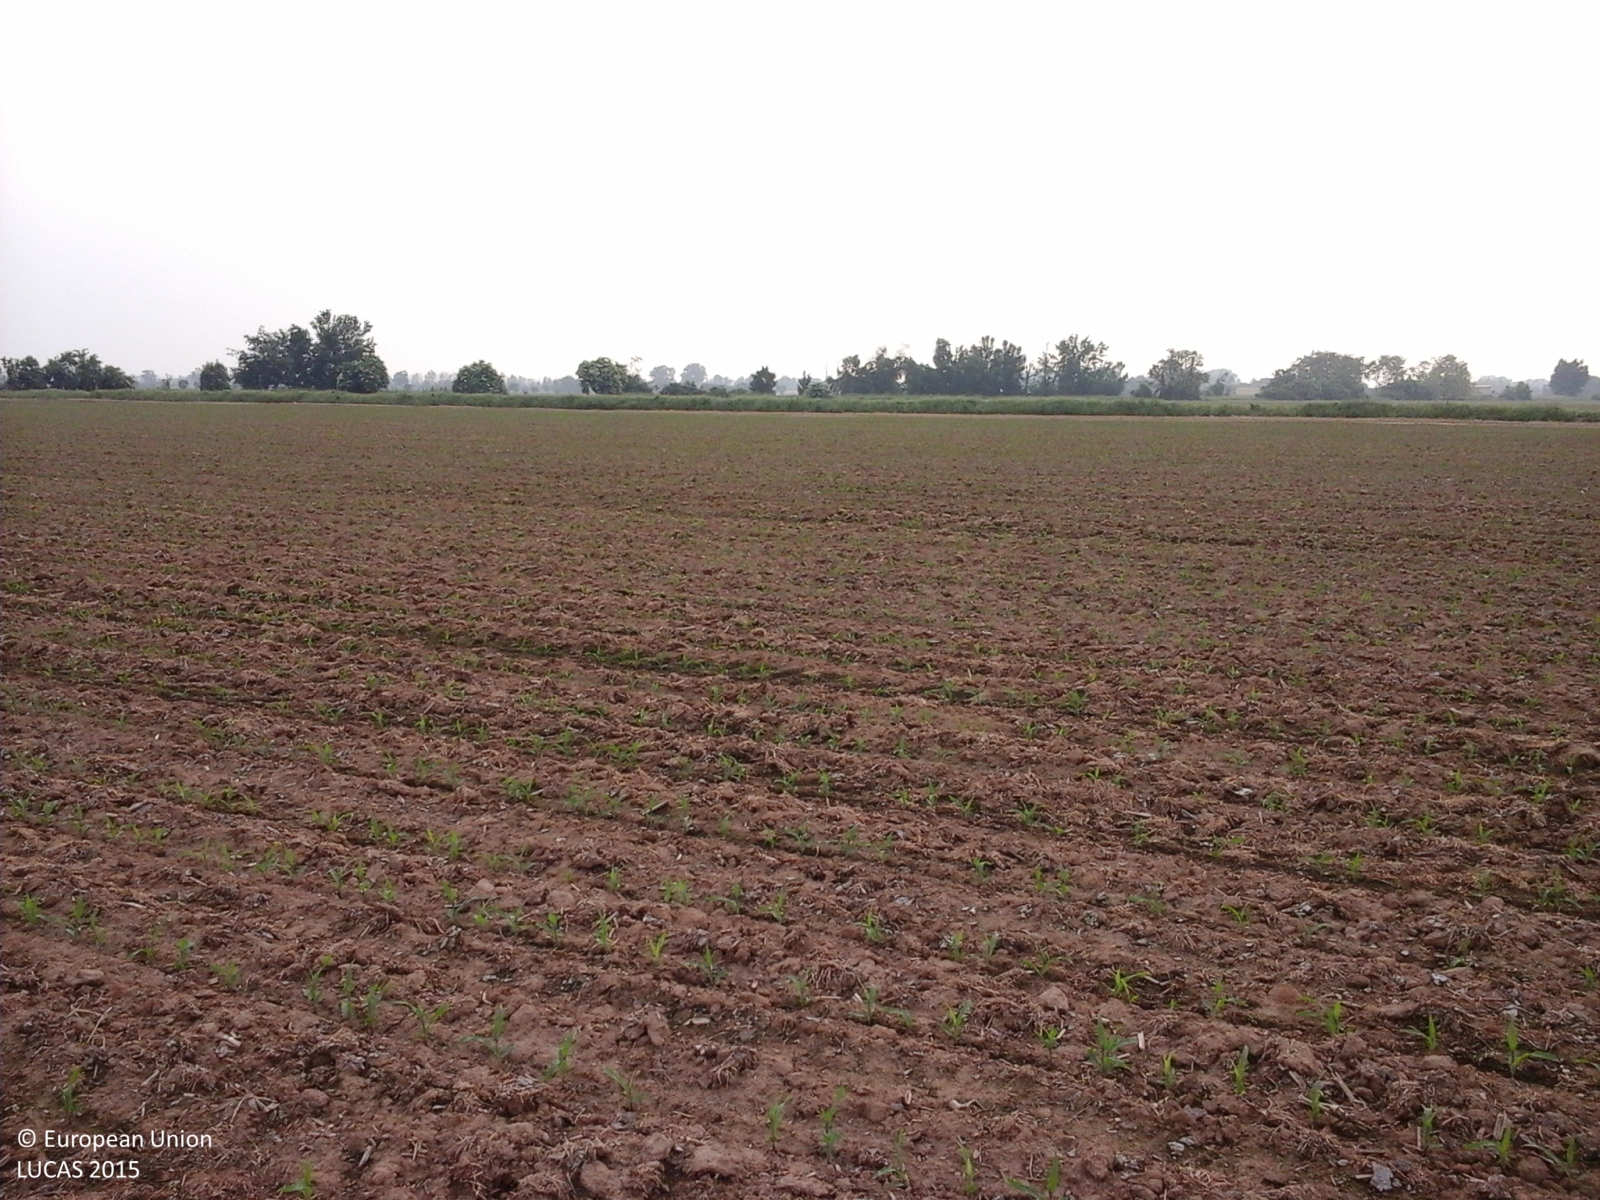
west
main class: Cropland
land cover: Maize
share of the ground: < 10 %
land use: Agriculture (excluding fallow land and kitchen gardens)
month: May
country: IT
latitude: 45.2340
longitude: 9.8601
